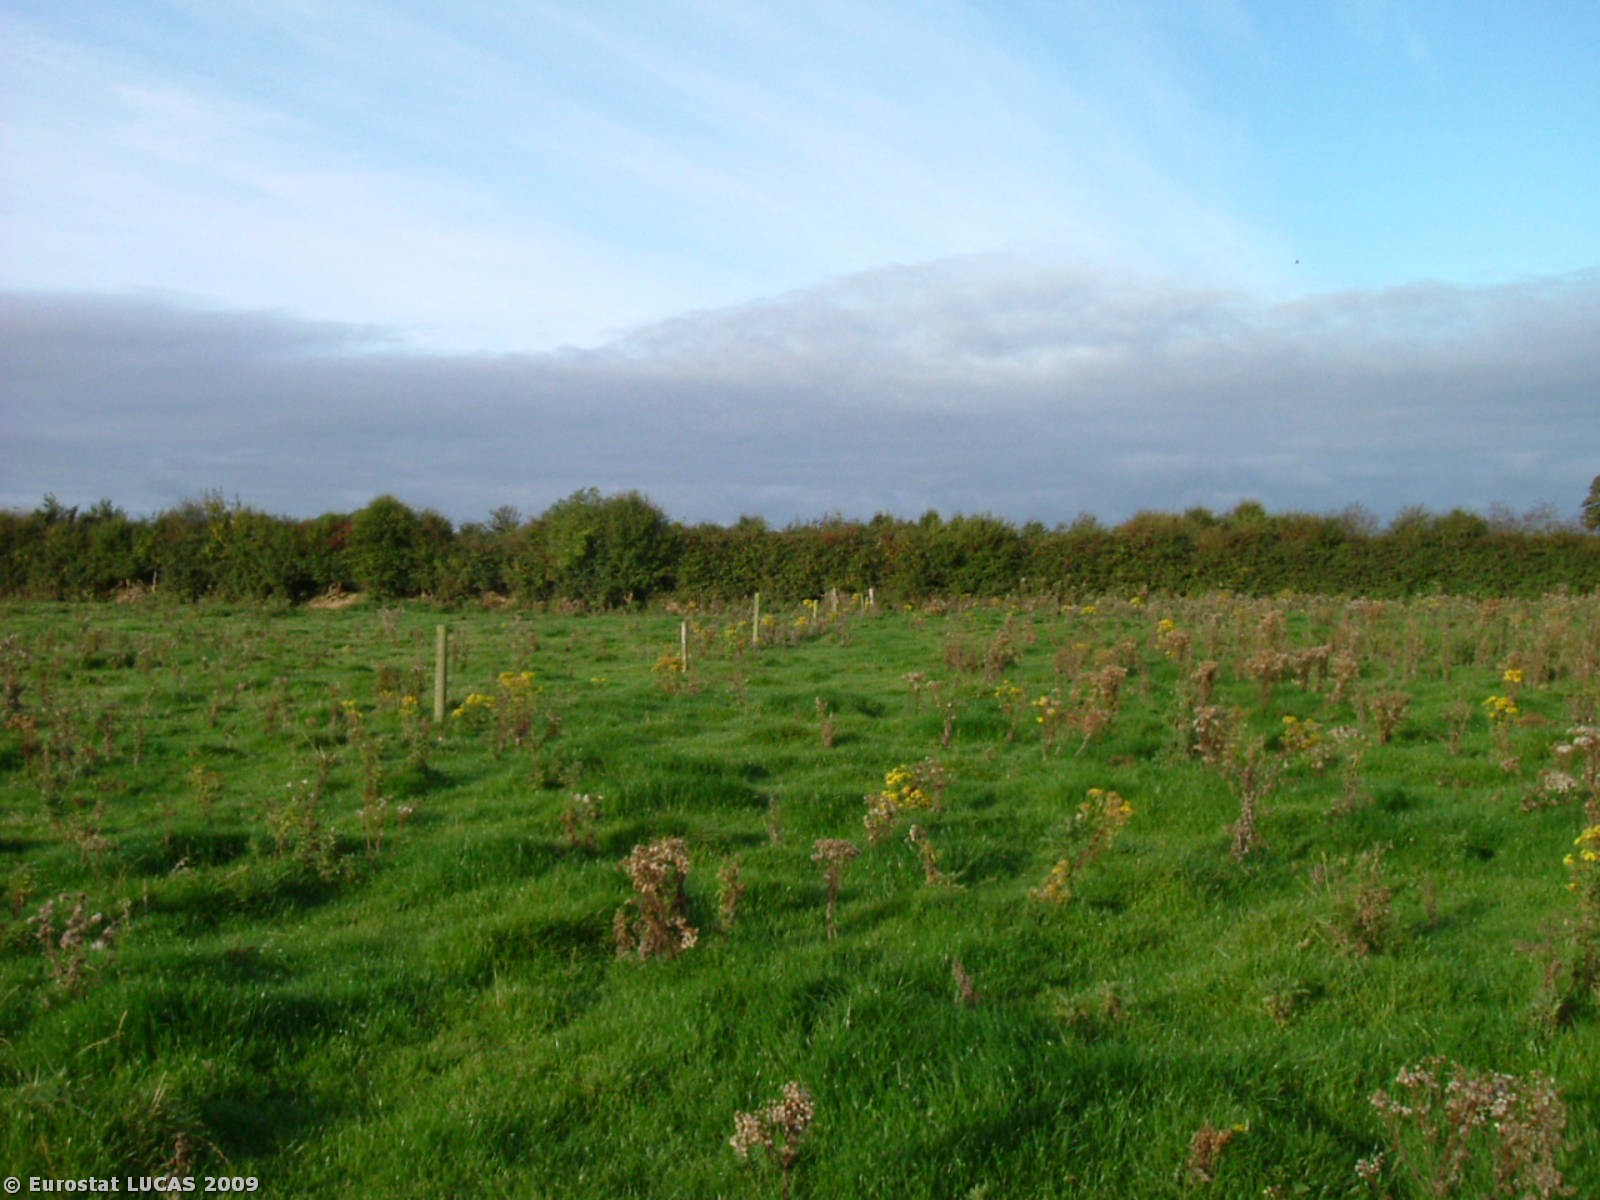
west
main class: Grassland
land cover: Grassland without tree/shrub cover
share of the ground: > 75 %
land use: Agriculture (excluding fallow land and kitchen gardens)
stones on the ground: < 10 %
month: October
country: IE
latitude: 52.6477
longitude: -7.7409
